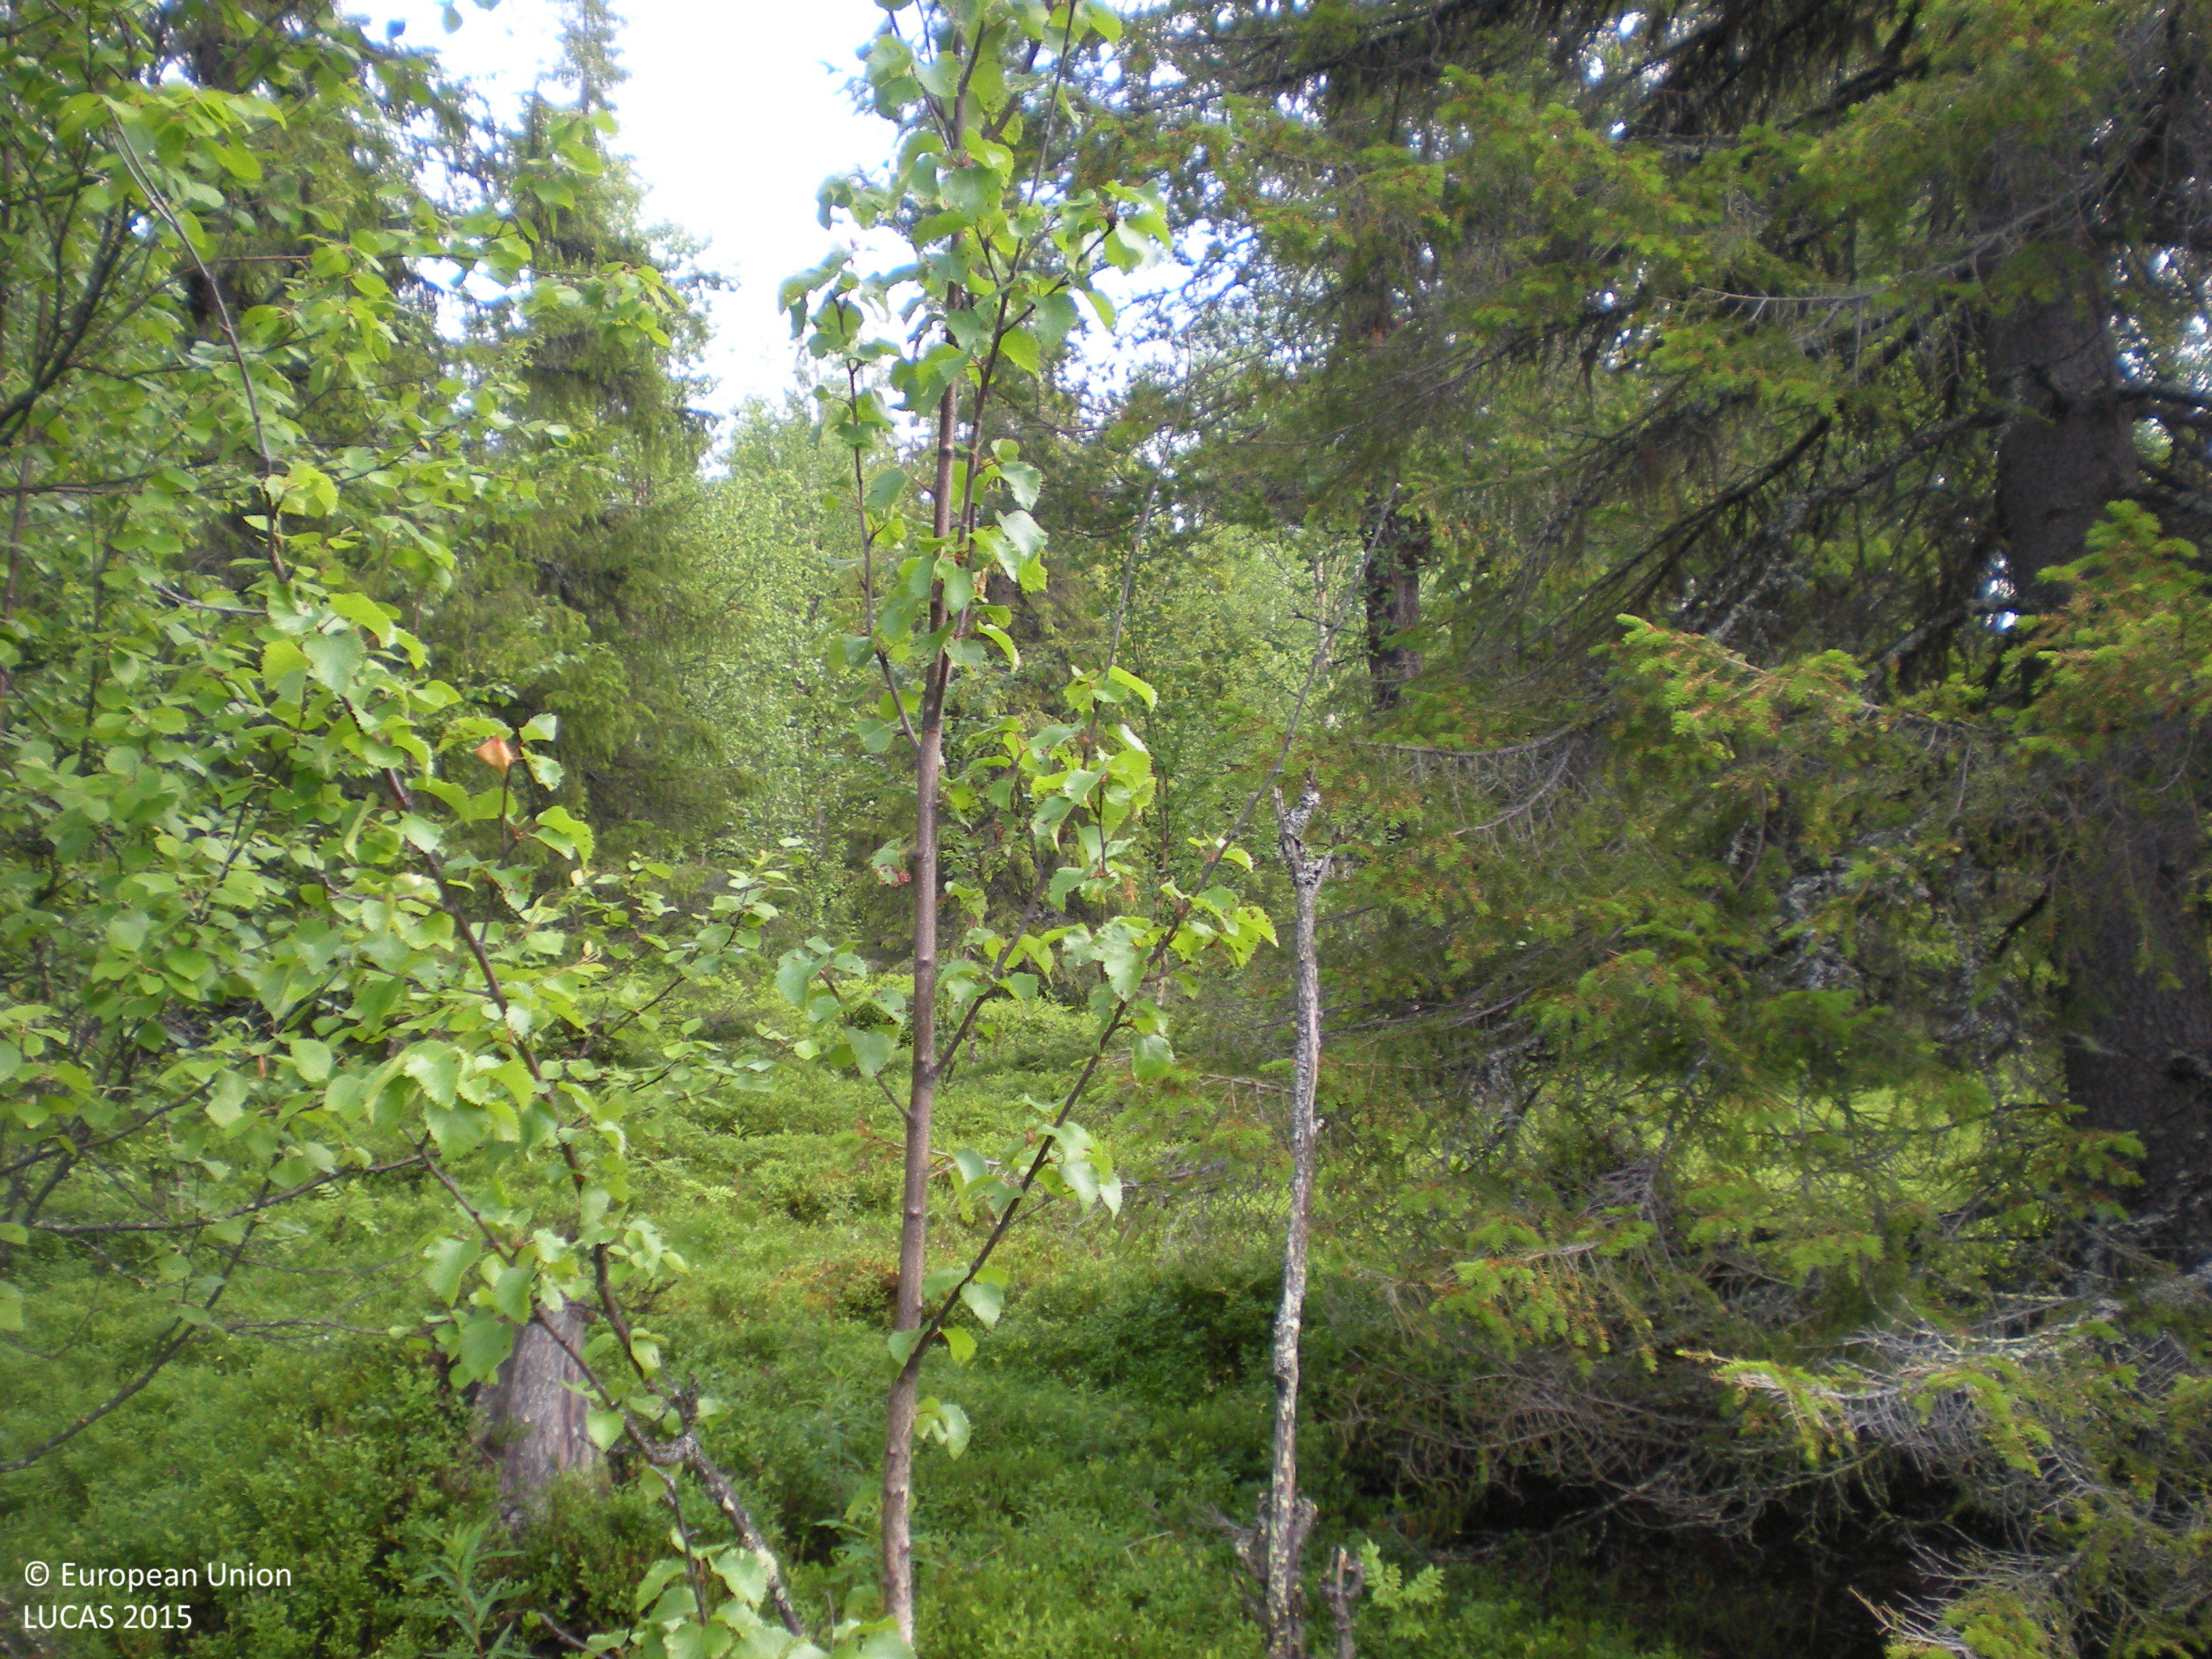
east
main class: Woodland
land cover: Other mixed woodland
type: boreal forest
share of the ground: 50 - 75 %
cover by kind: coniferous forest trees 40 %, shrubs 30 %, broadleaved forest trees 25 %, lichens and mosses 5 %
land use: Semi-natural and natural areas not in use
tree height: > 5 m
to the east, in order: Other mixed woodland; Spruce dominated coniferous woodland; Spruce dominated mixed woodland
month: July
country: SE
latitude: 65.8341
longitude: 16.7230
